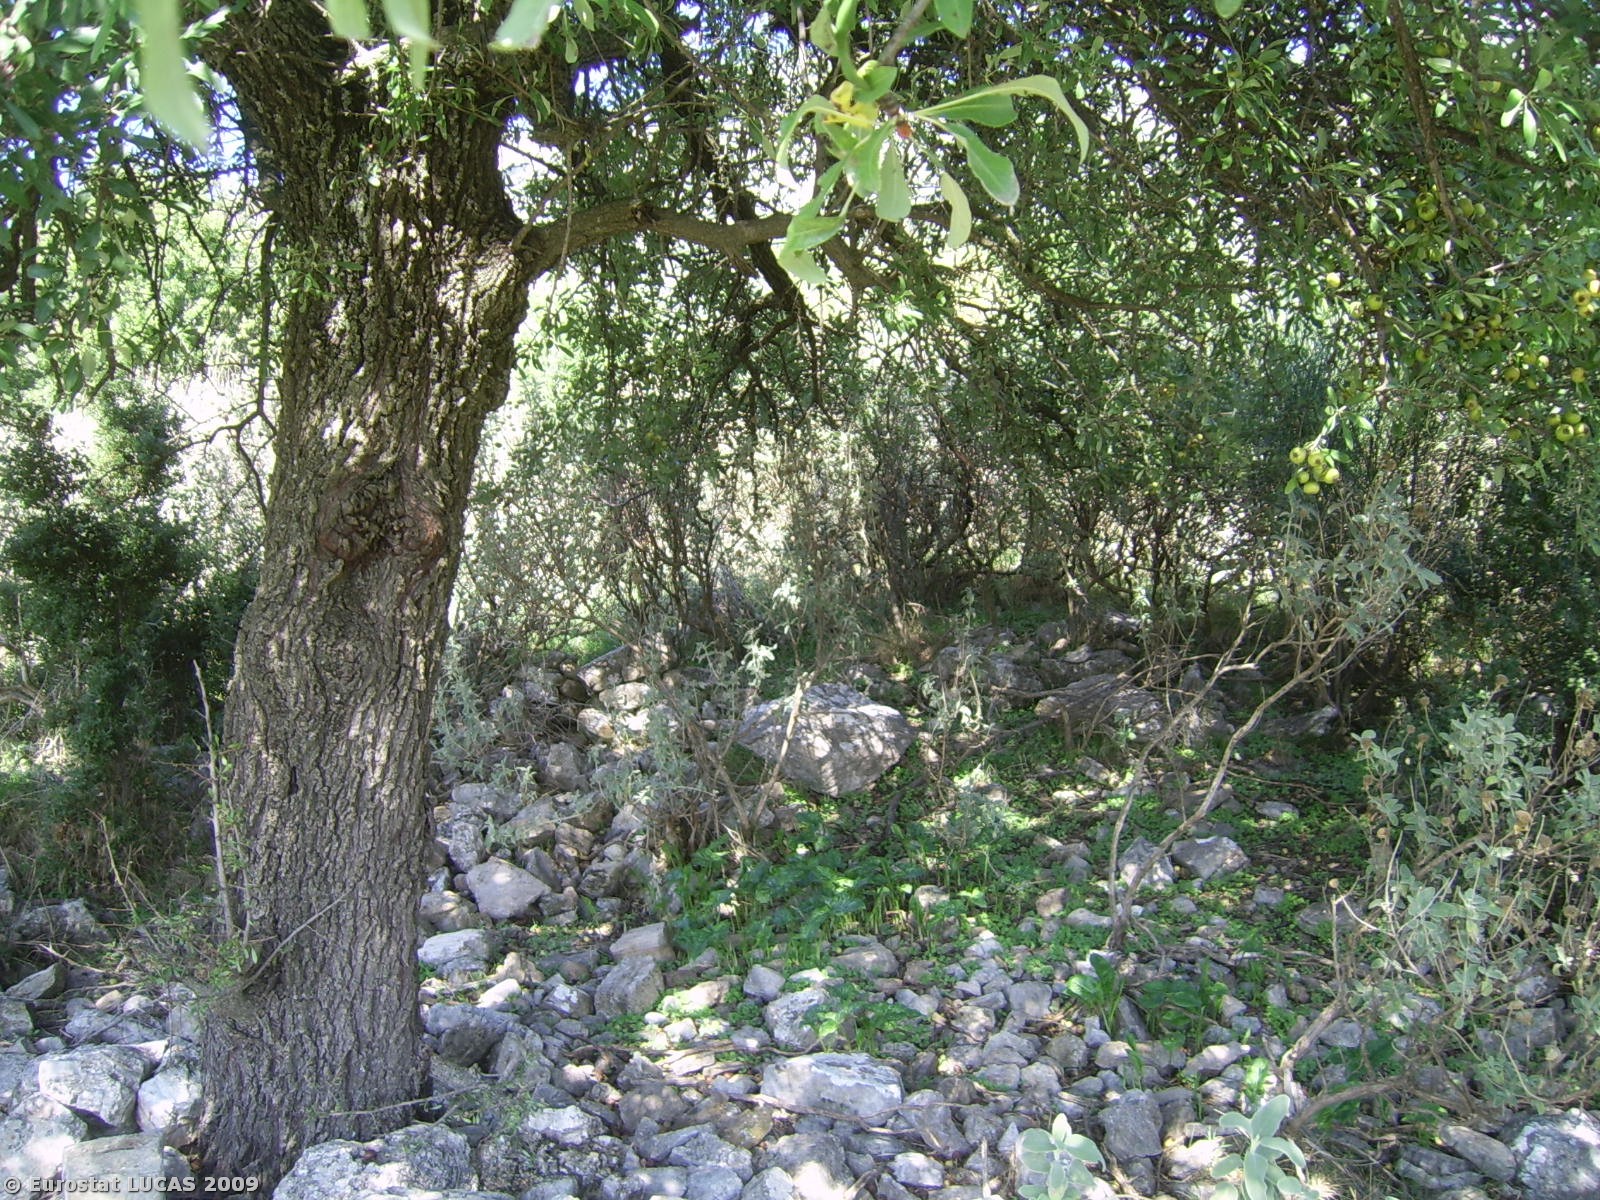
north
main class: Grassland
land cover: Grassland with sparse tree/shrub cover
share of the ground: > 75 %
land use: Unused
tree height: > 5 m
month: October
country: GR
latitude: 37.8461
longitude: 21.7015
